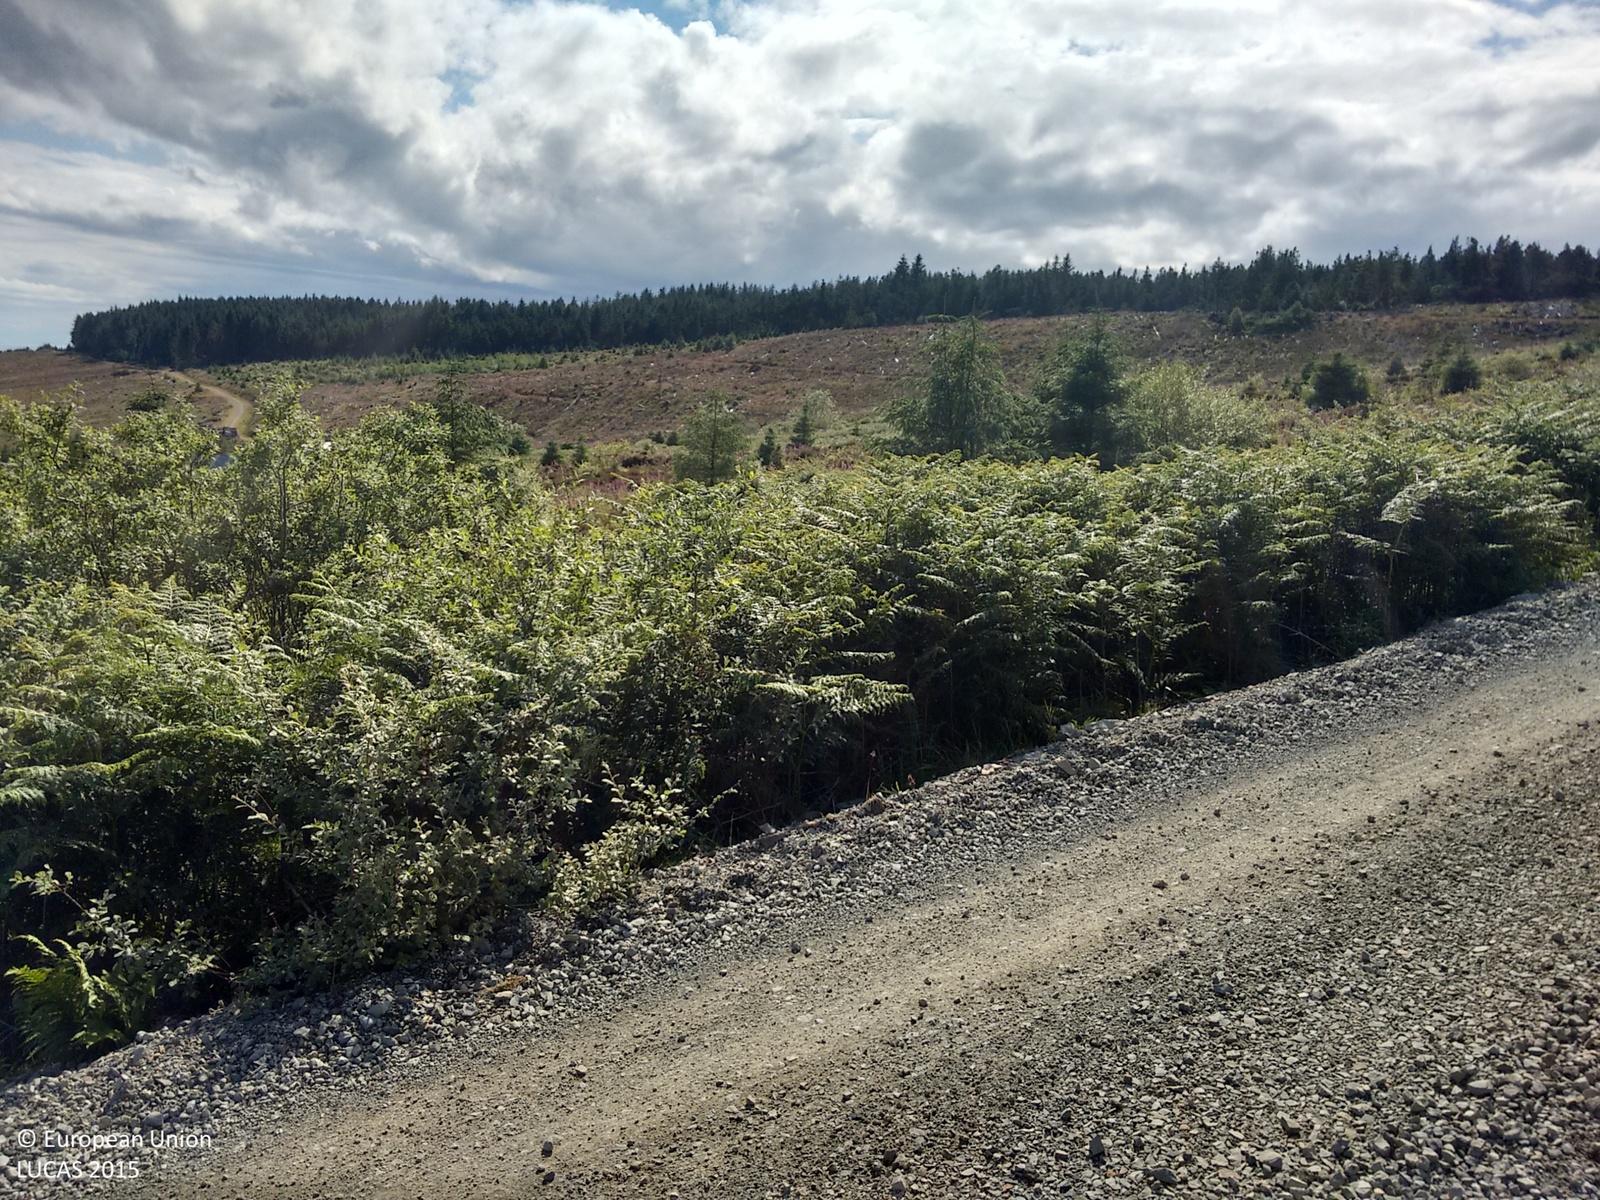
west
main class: Shrubland
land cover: Shrubland with sparse tree cover
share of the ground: > 75 %
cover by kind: shrubs 95 %, coniferous forest trees 5 %
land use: Semi-natural and natural areas not in use
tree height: < 5 m
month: July
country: GB
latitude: 55.4768
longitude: -5.1945
